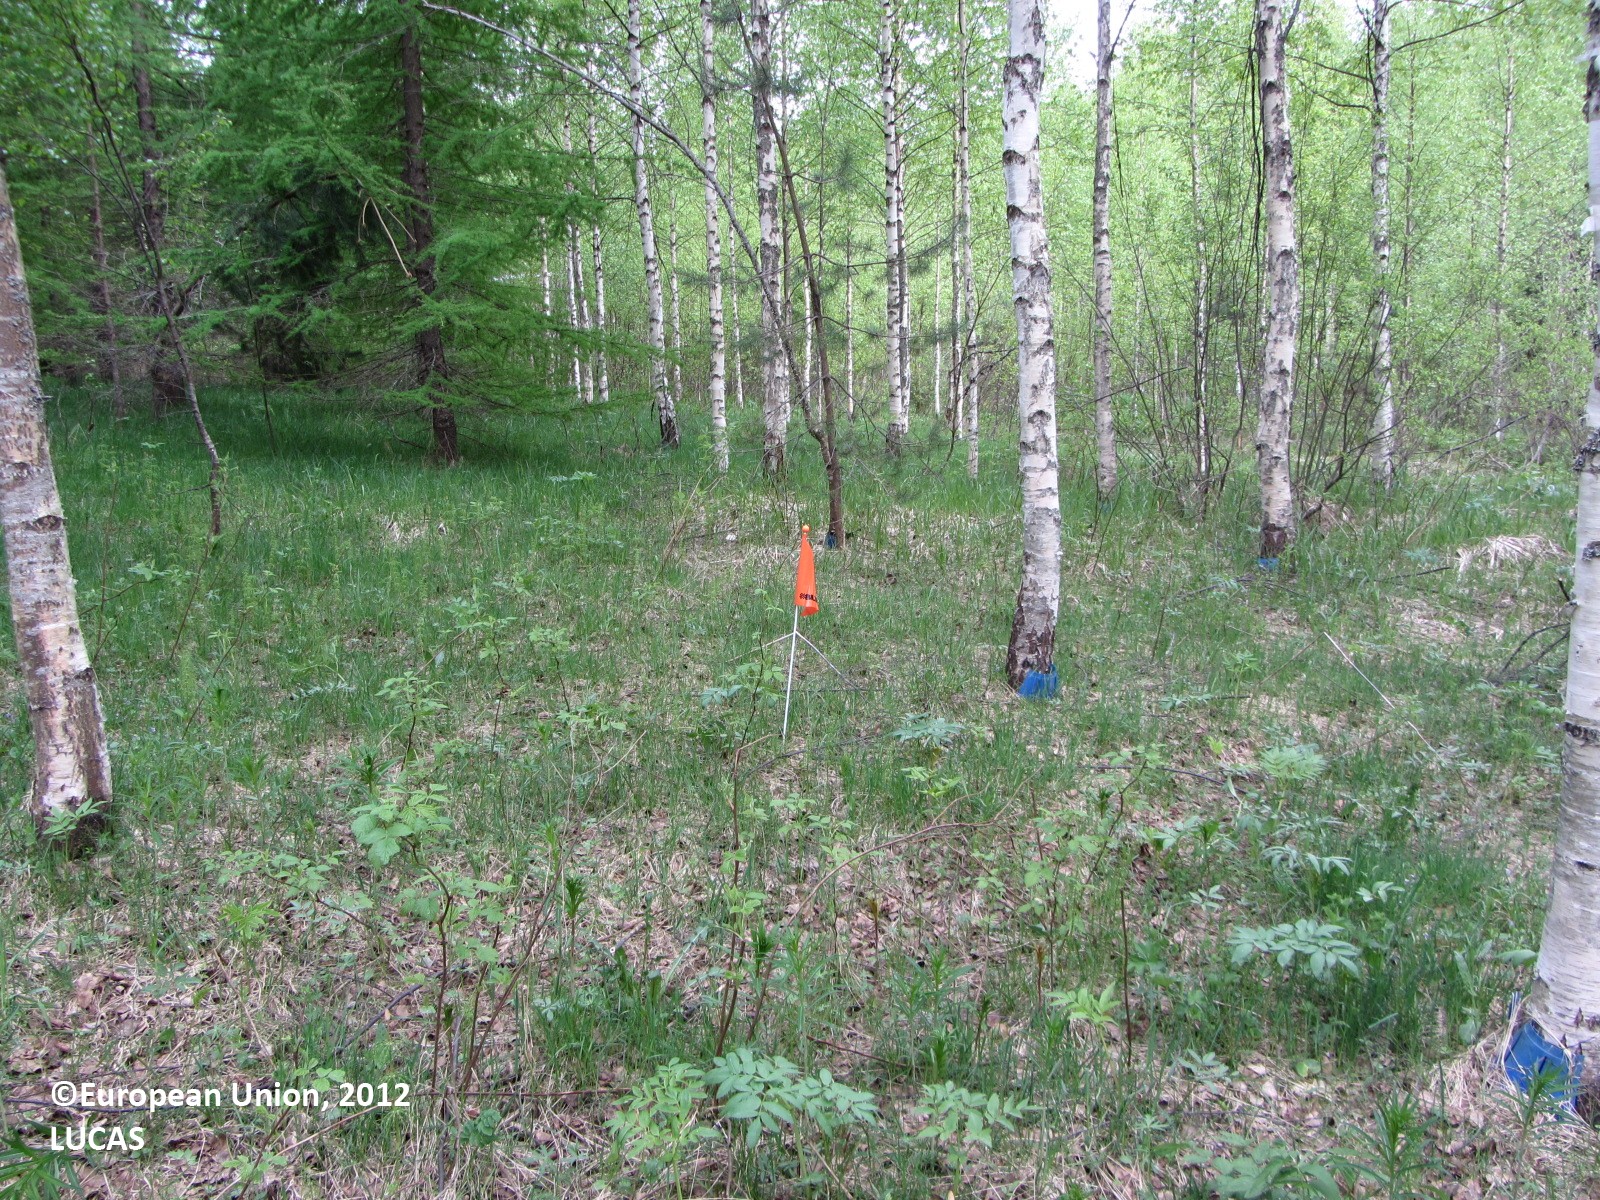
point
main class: Woodland
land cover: Broadleaved woodland
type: boreal forest
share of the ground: > 75 %
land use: Forestry
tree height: > 5 m
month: May
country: FI
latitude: 62.4014
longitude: 25.4156
